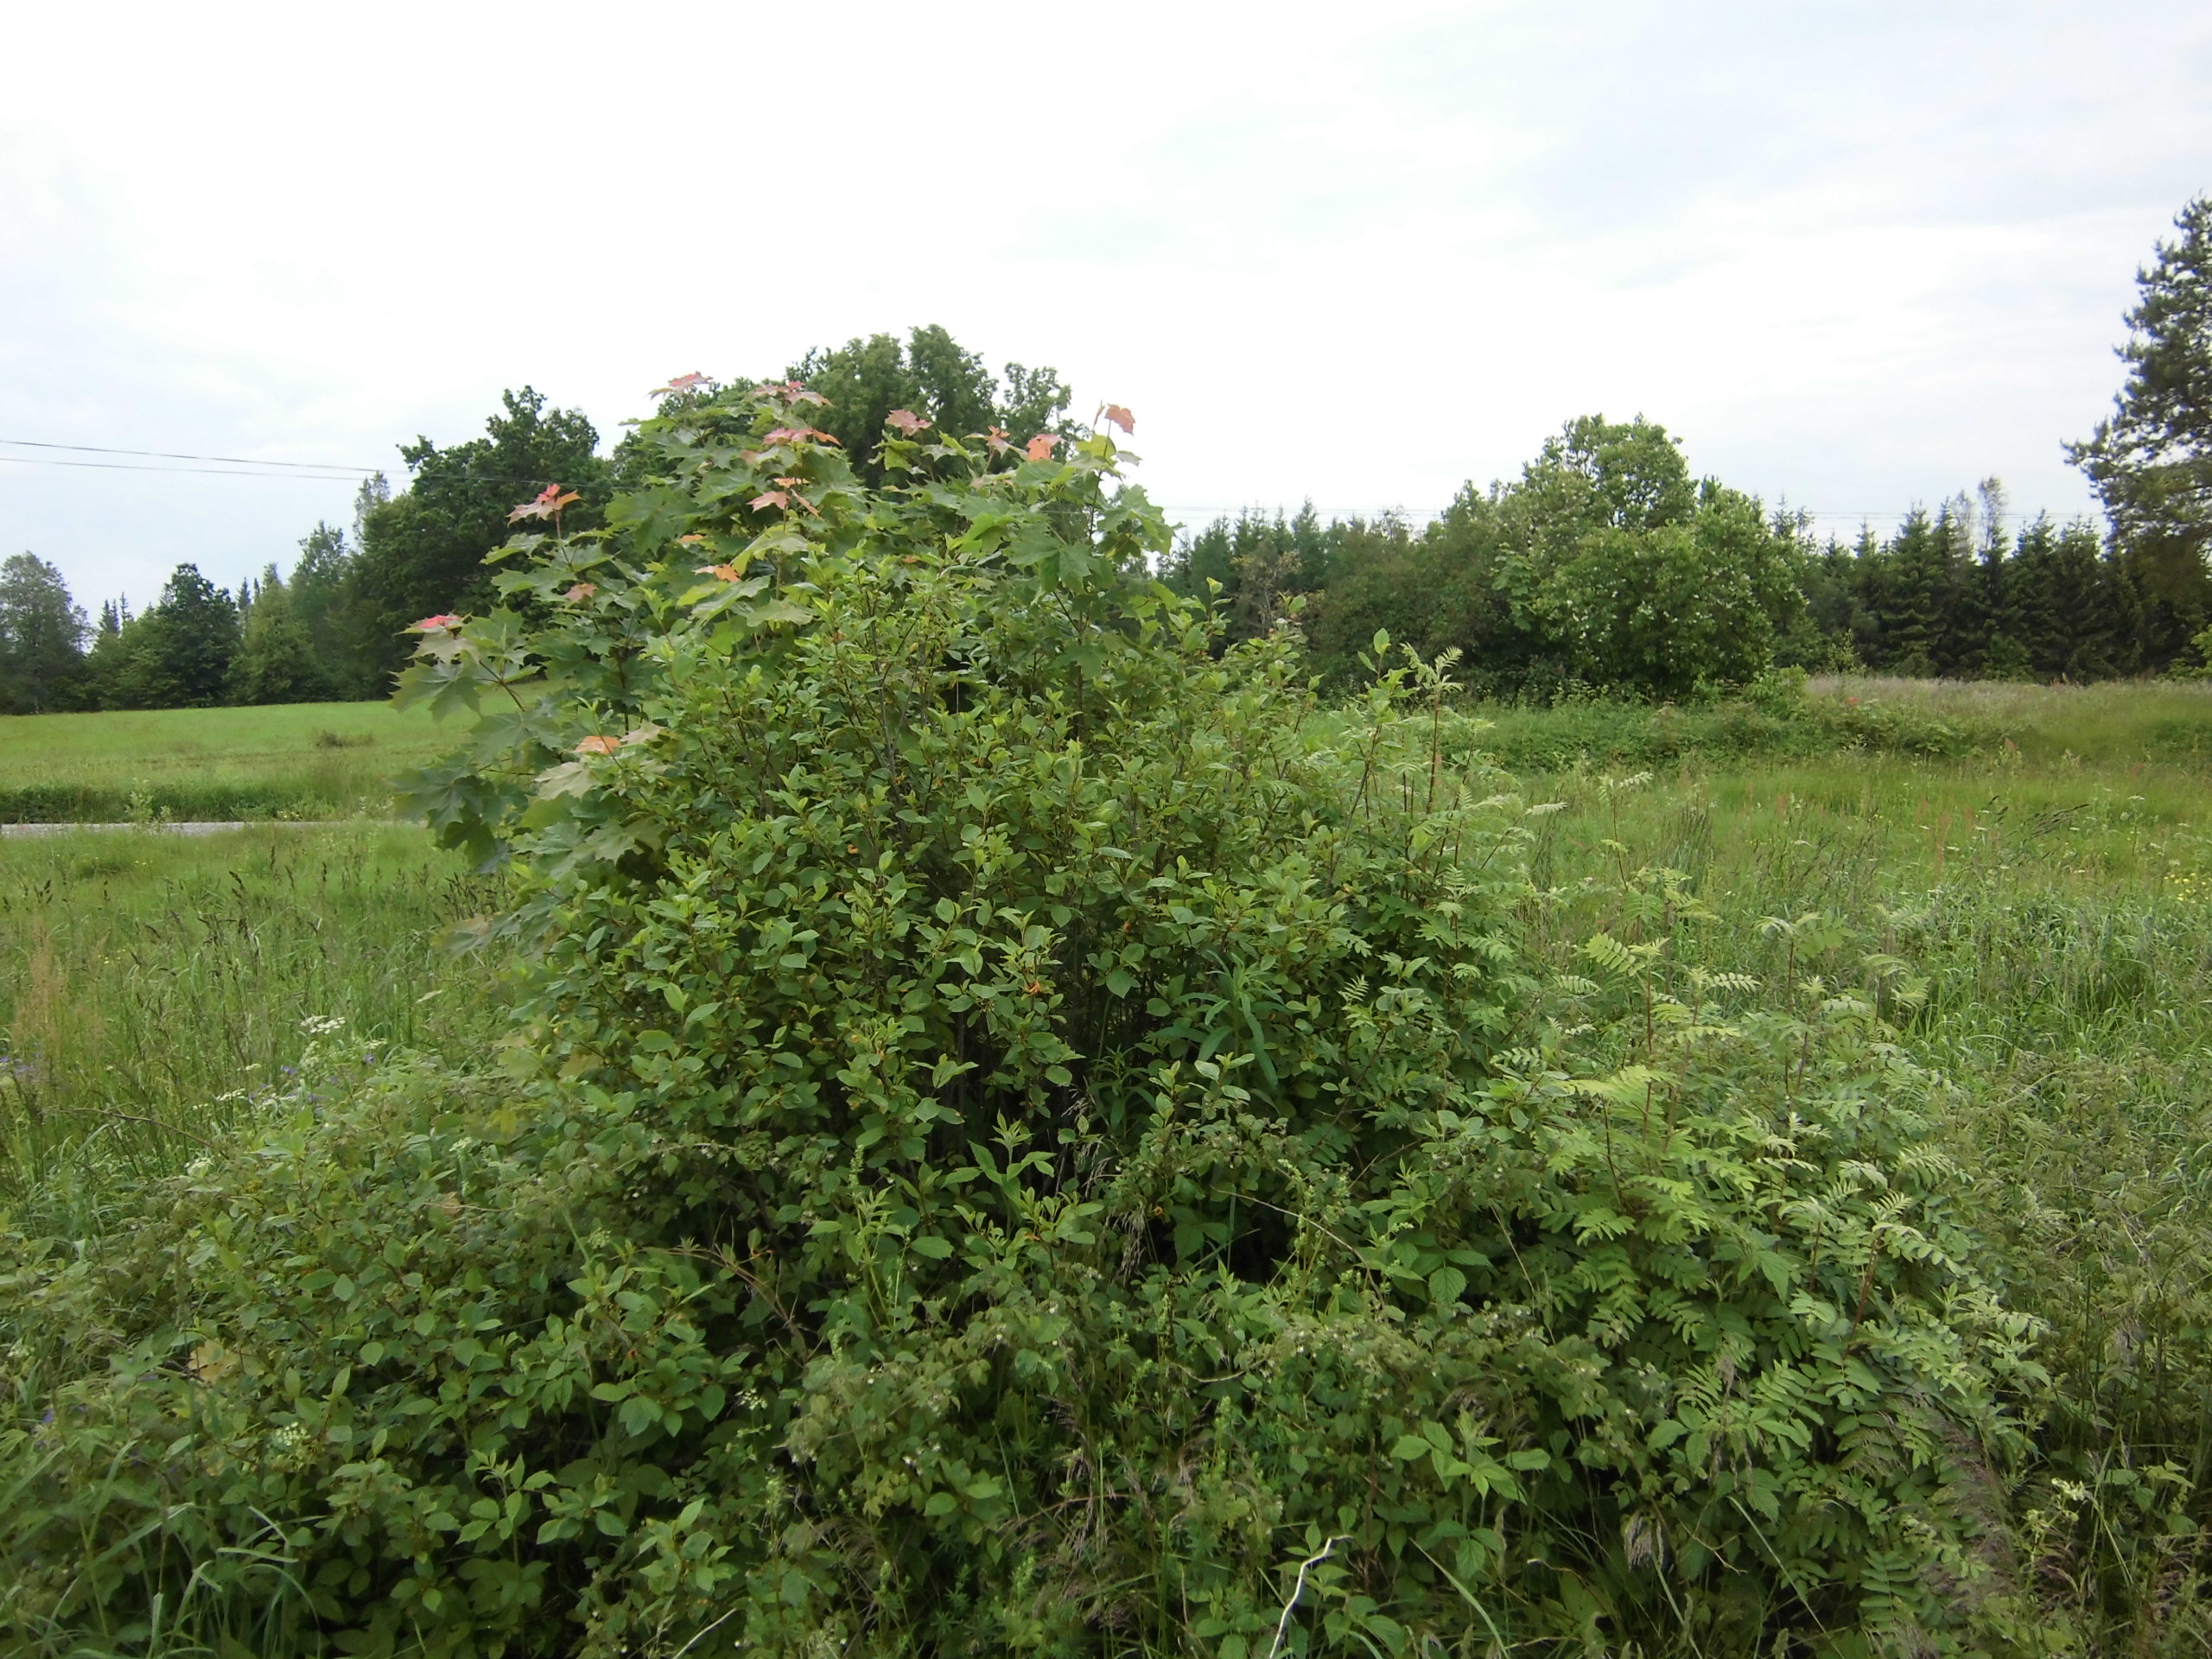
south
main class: Grassland
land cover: Grassland without tree/shrub cover
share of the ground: > 75 %
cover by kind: herbaceous plants 100 %
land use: Agriculture (excluding fallow land and kitchen gardens)
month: June
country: SE
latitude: 57.0409
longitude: 14.6278
